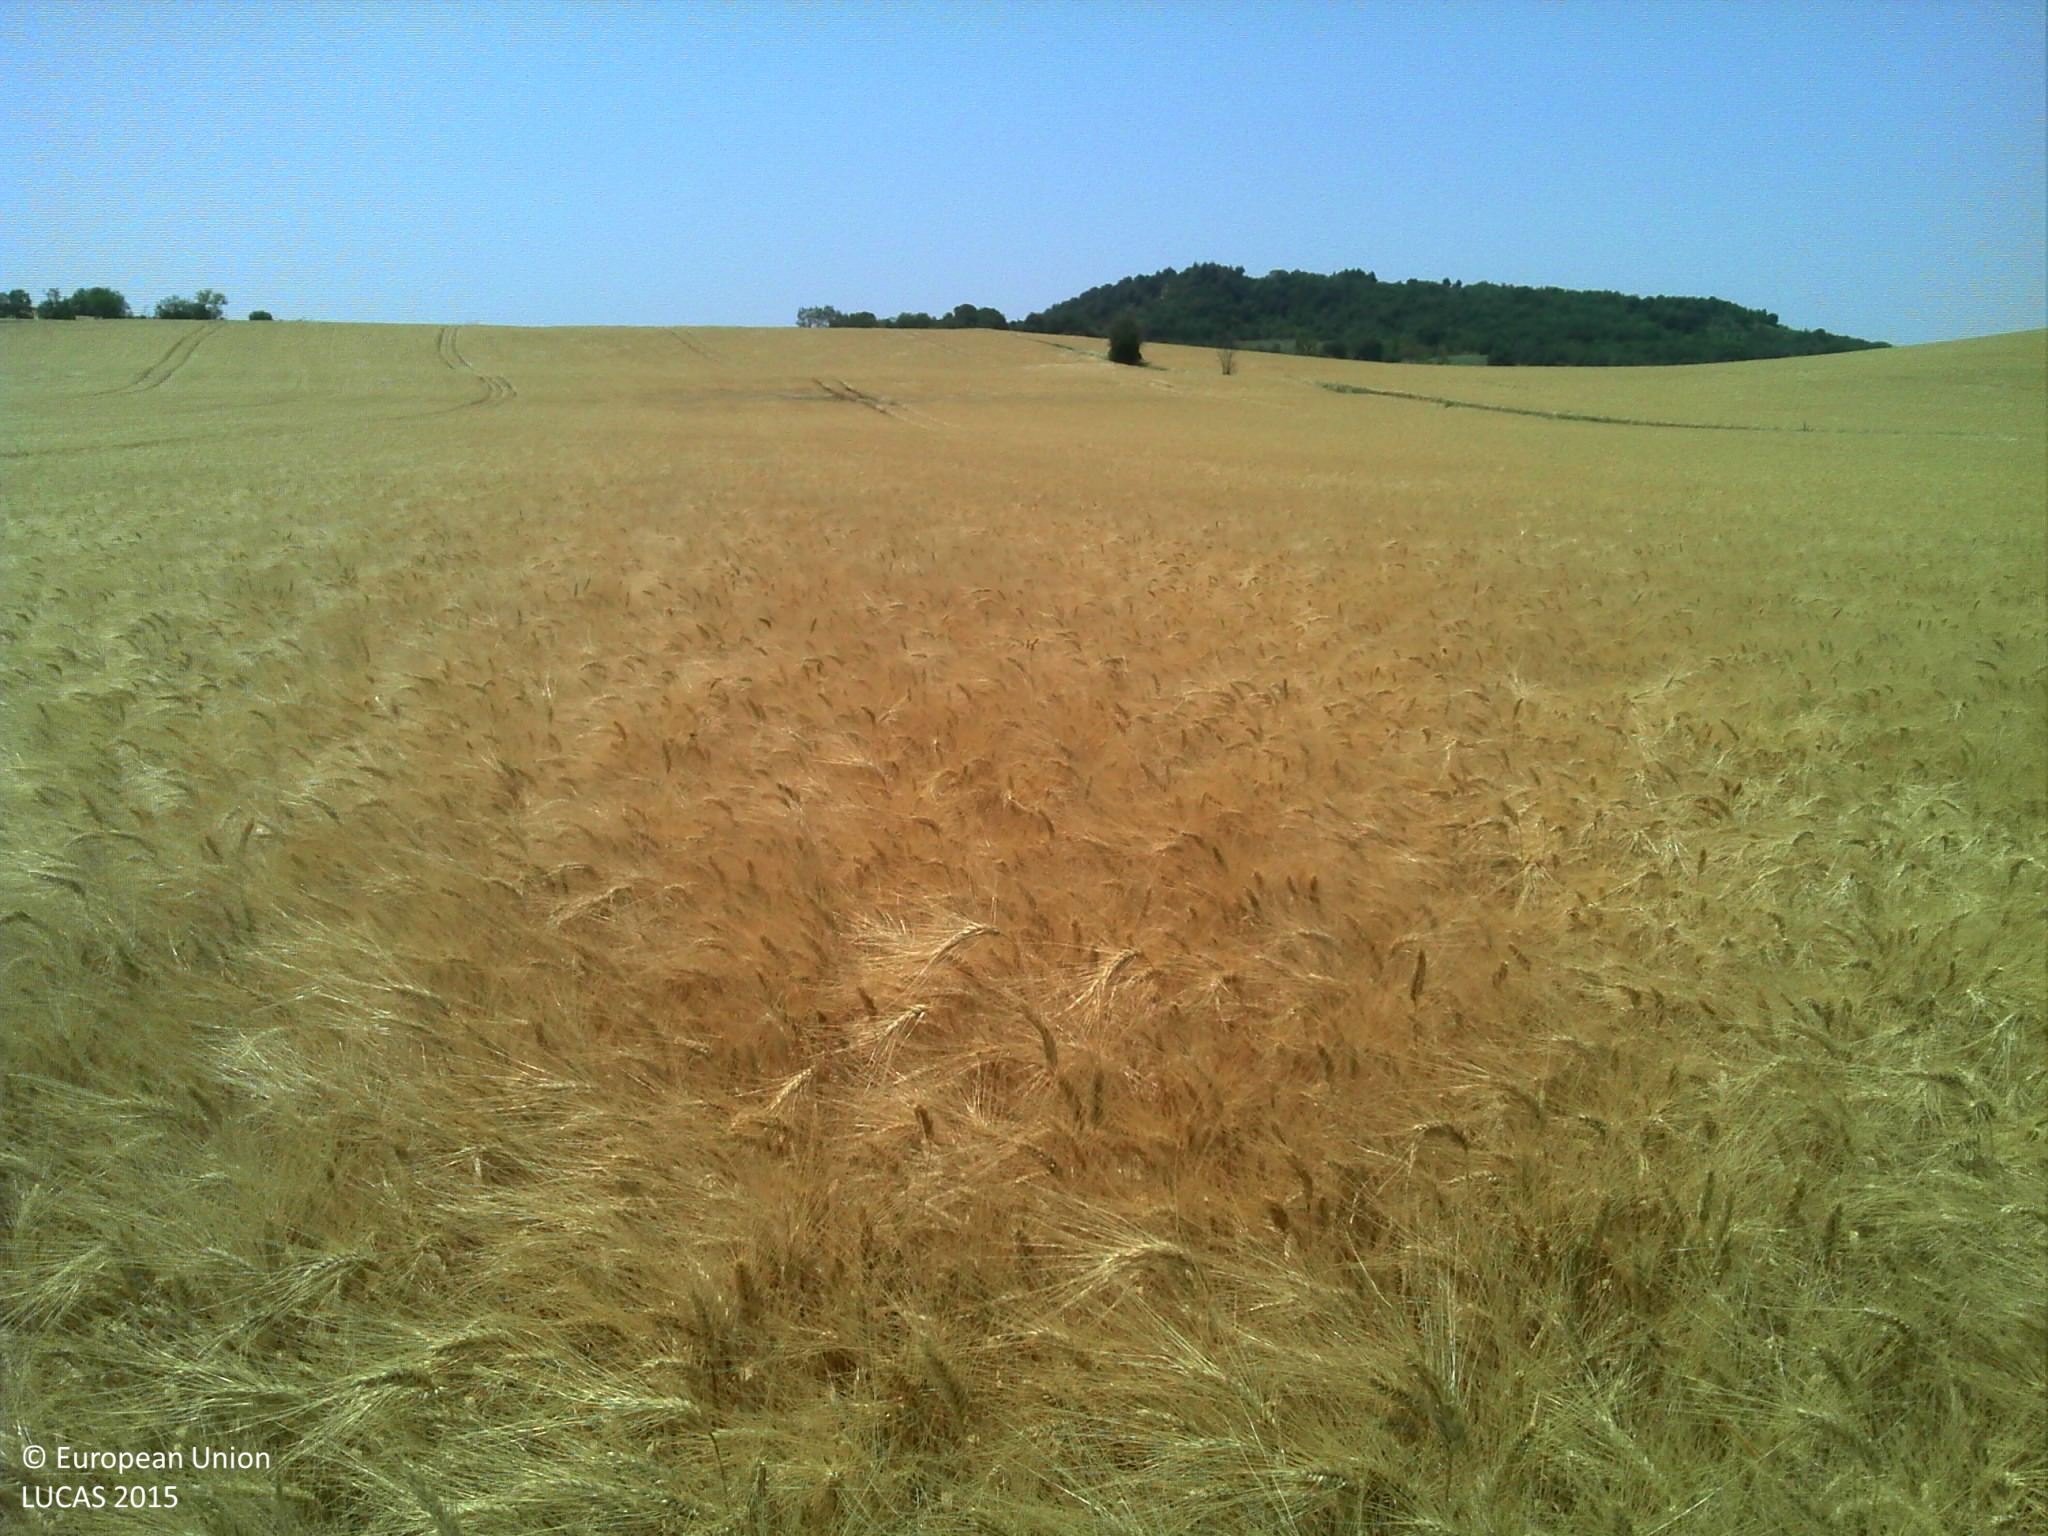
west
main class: Cropland
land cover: Durum wheat
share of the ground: > 75 %
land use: Agriculture (excluding fallow land and kitchen gardens)
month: June
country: FR
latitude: 43.2111
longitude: 2.0432
